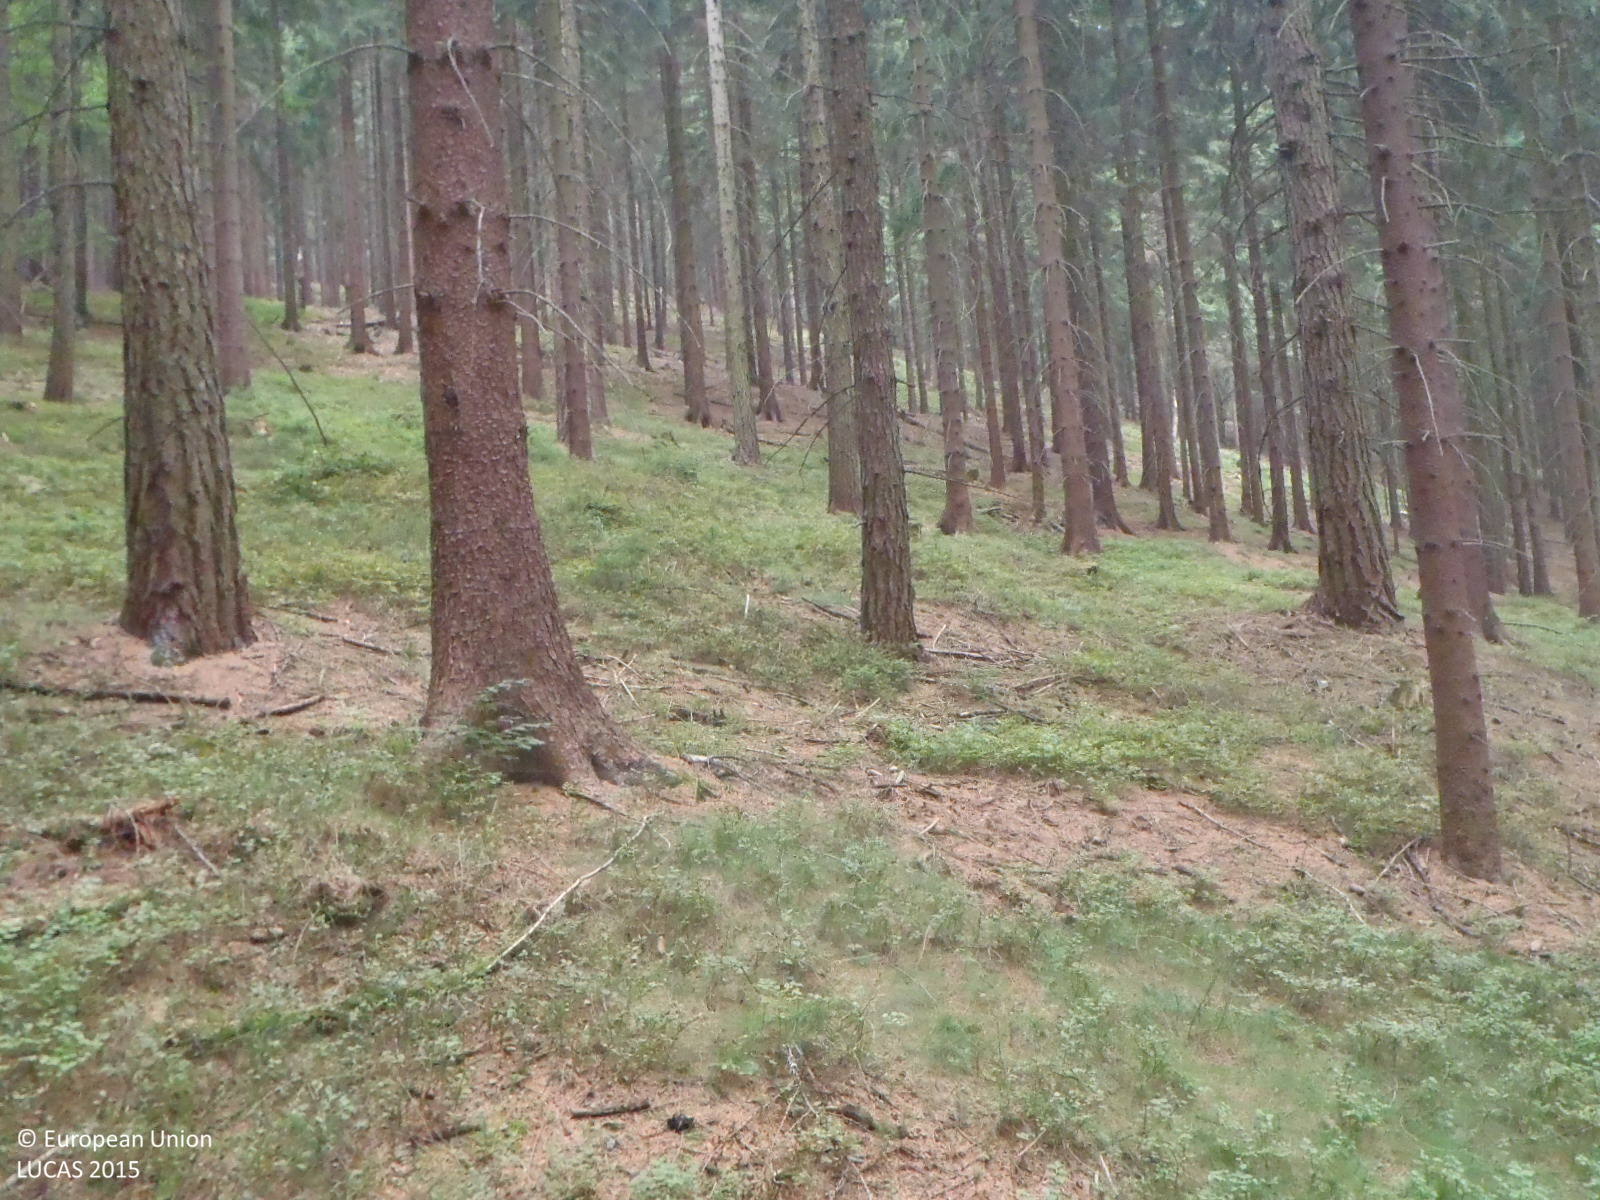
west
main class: Woodland
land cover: Spruce dominated coniferous woodland
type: hemiboreal forest and nemoral coniferous forest and mixed broadleaved-coniferous forest
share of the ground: > 75 %
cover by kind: coniferous forest trees 100 %
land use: Forestry
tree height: > 5 m
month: August
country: CZ
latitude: 50.7601
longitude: 14.9788
